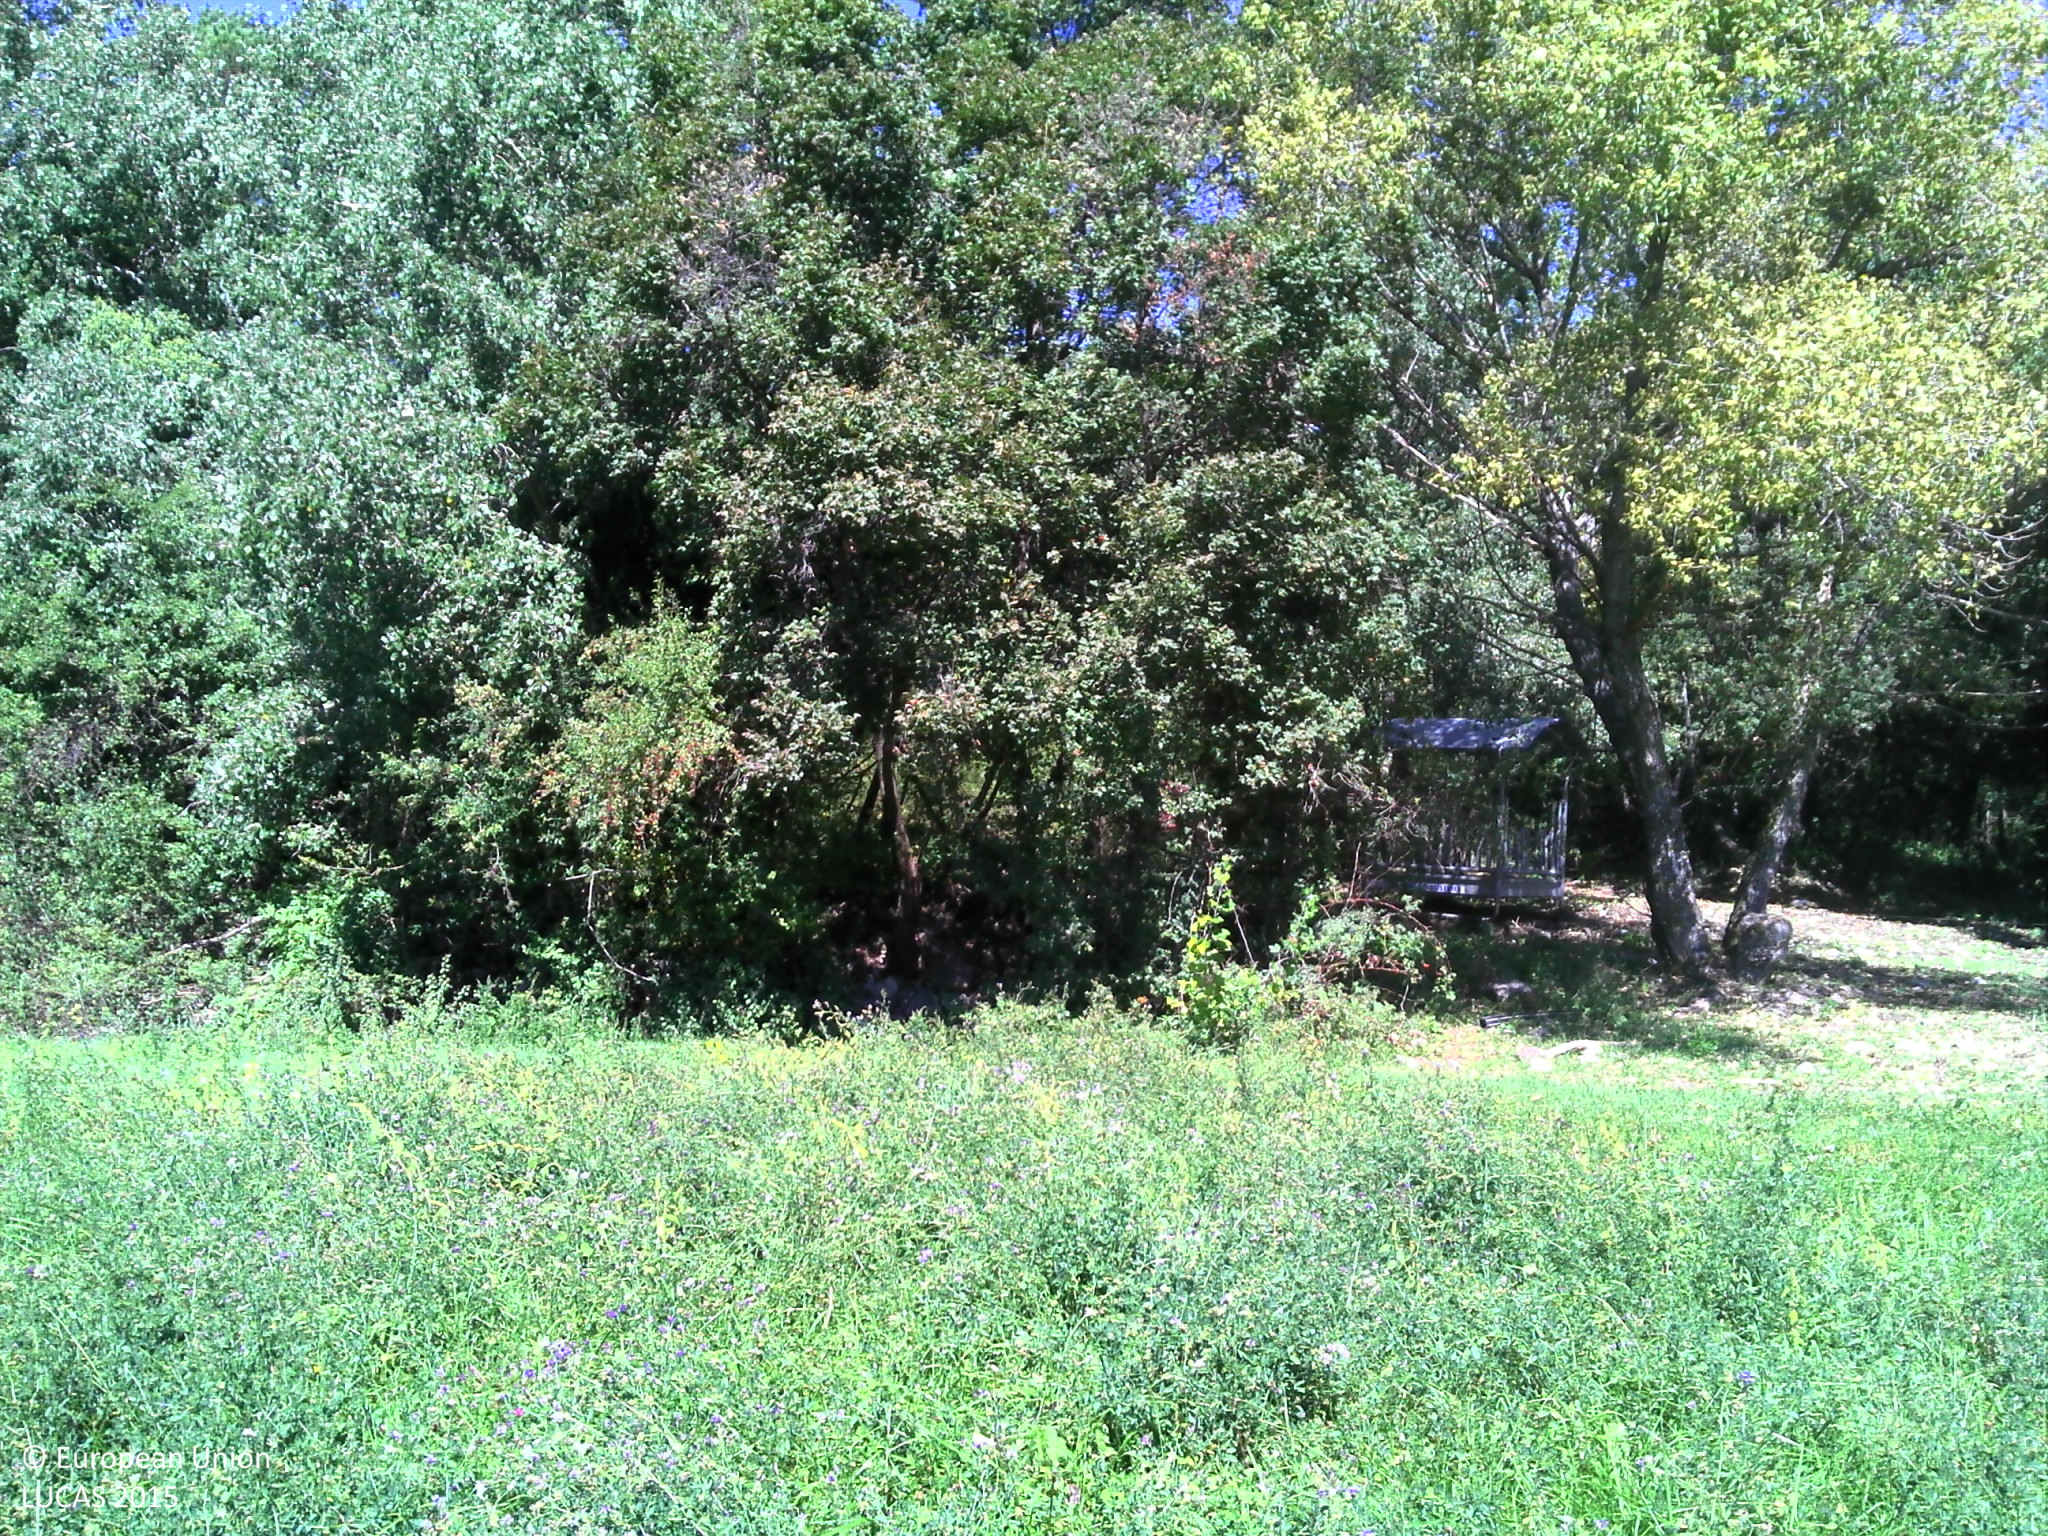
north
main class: Cropland
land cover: Lucerne
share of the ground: > 75 %
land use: Agriculture (excluding fallow land and kitchen gardens)
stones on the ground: < 10 %
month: September
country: FR
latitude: 44.5704
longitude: 6.2163
